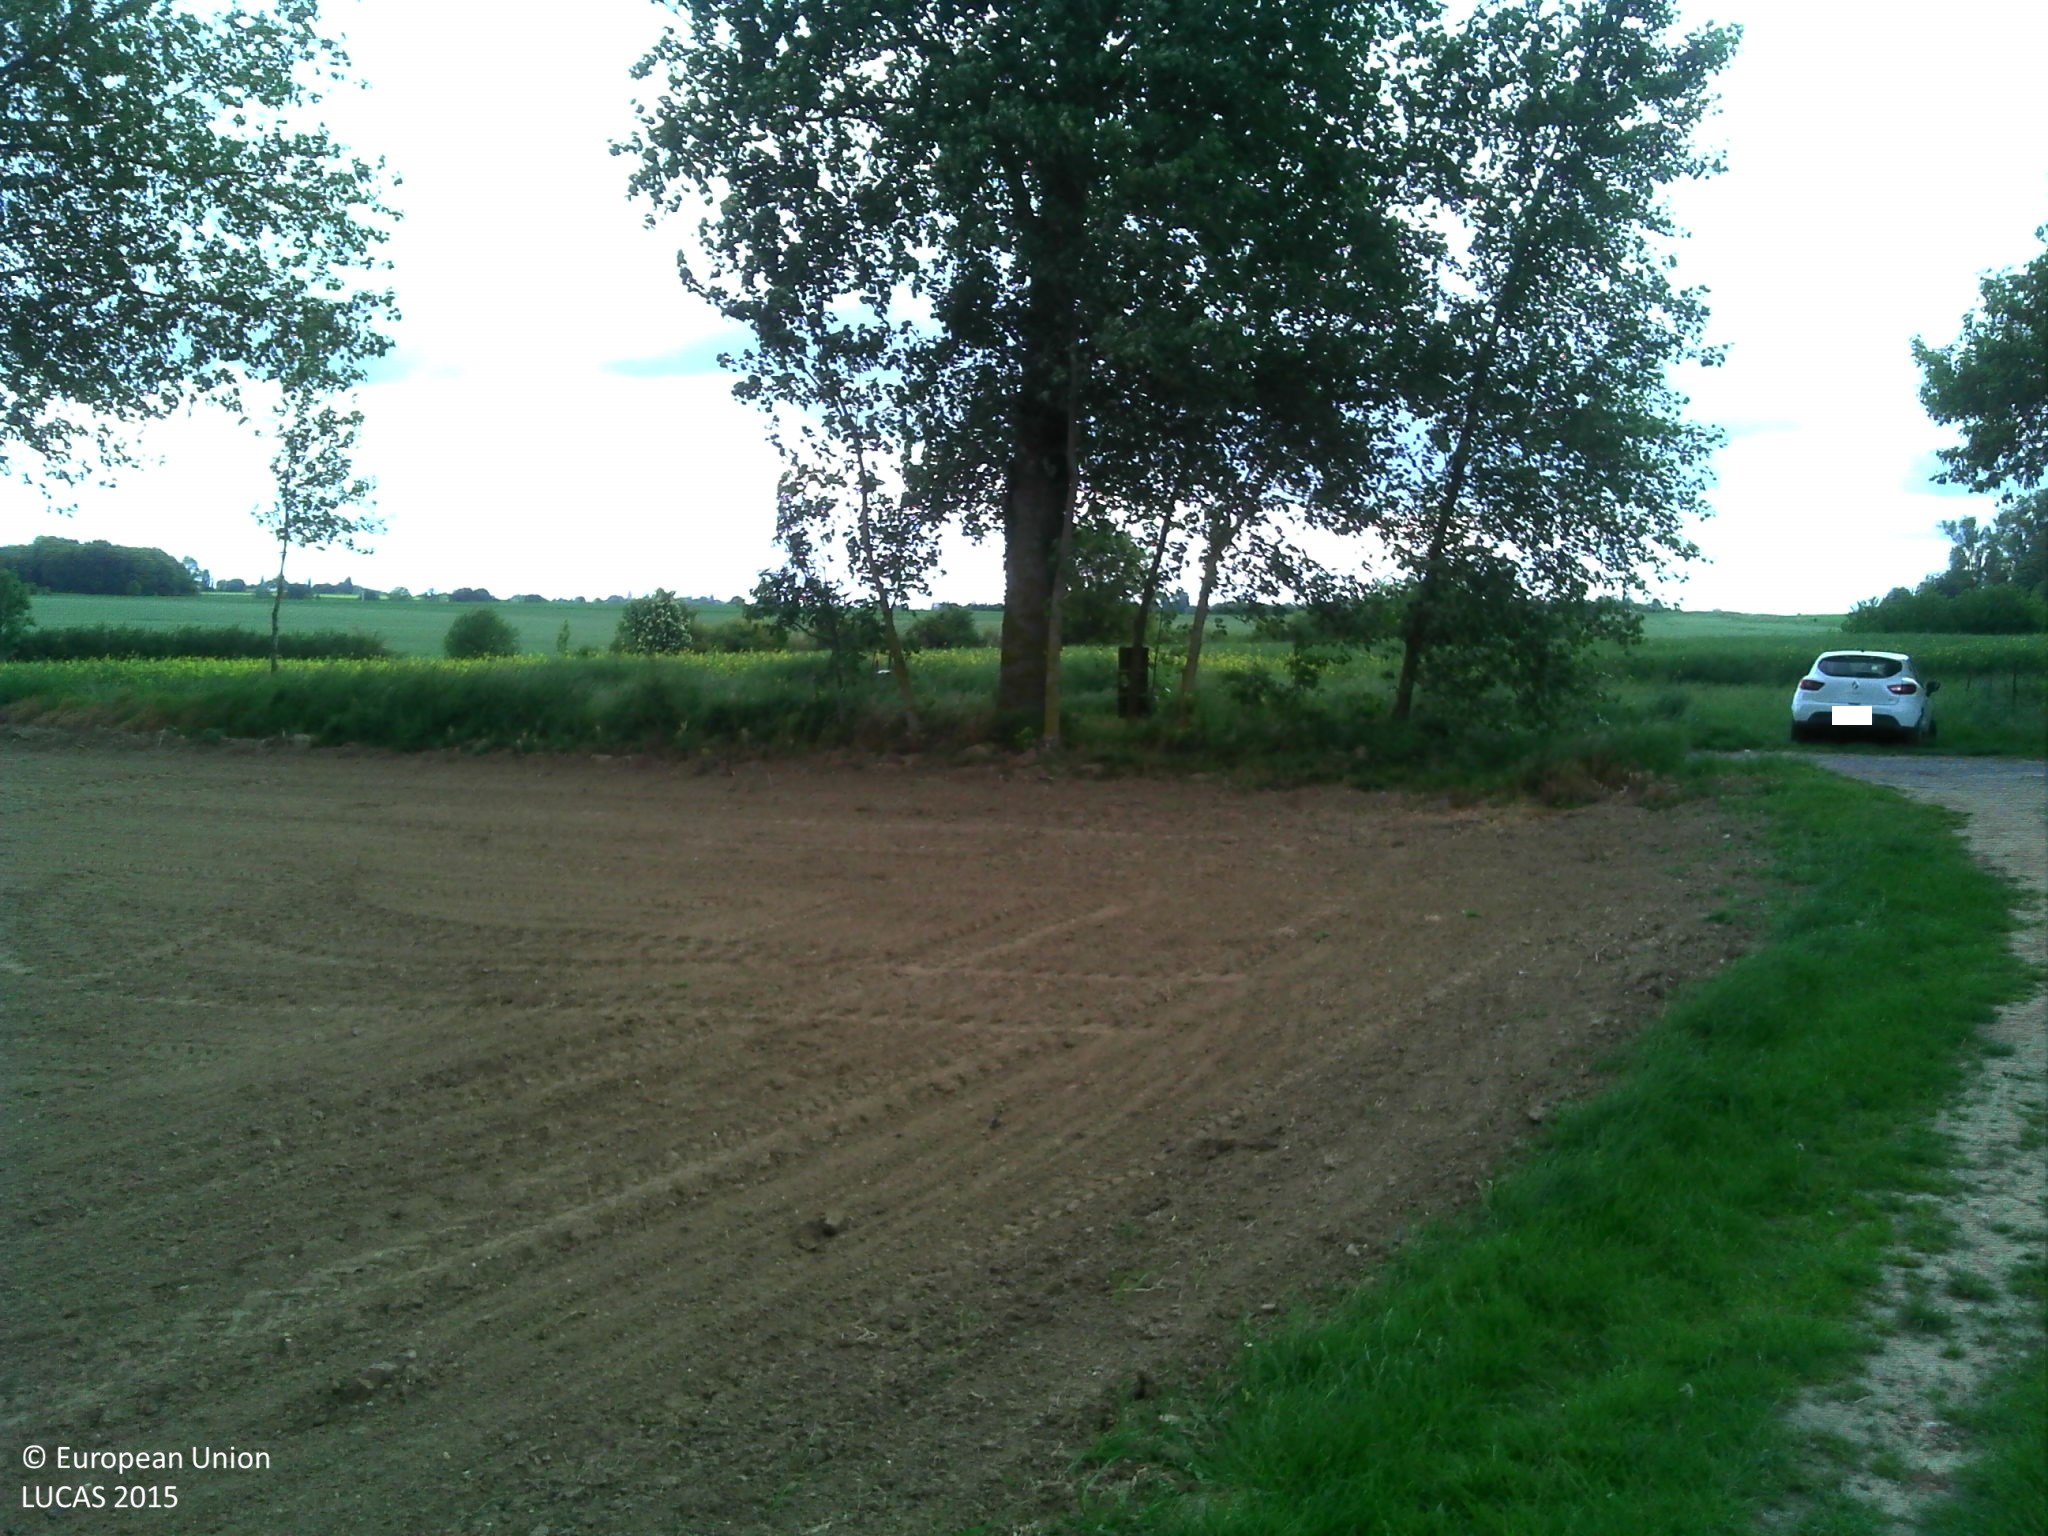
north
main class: Grassland
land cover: Grassland with sparse tree/shrub cover
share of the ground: > 75 %
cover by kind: herbaceous plants 95 %, broadleaved forest trees 5 %
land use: Residential
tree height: > 5 m
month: May
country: FR
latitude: 49.8380
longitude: 3.2200
